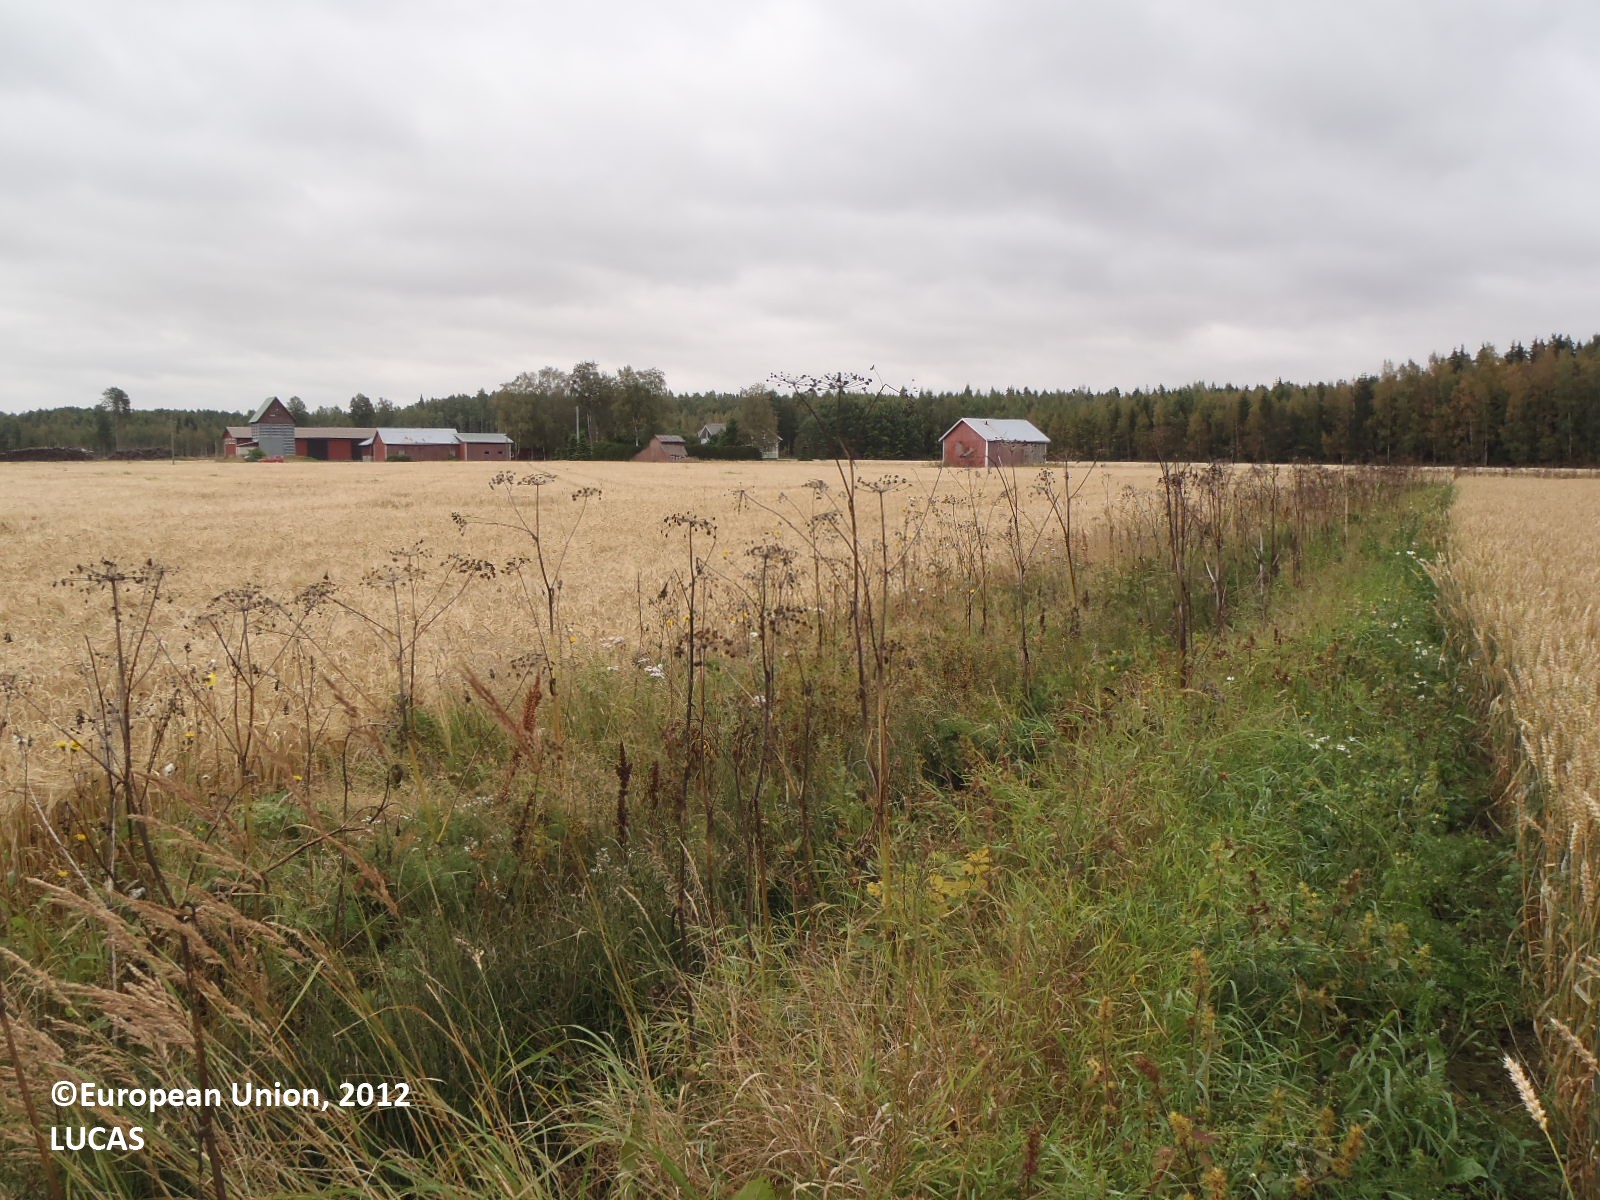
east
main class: Cropland
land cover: Common wheat
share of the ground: > 75 %
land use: Agriculture (excluding fallow land and kitchen gardens)
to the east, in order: Common wheat; Tracks; Grass margins; Ditches and canals; Grass margins; Barley
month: September
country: FI
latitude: 60.7792
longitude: 22.8363
